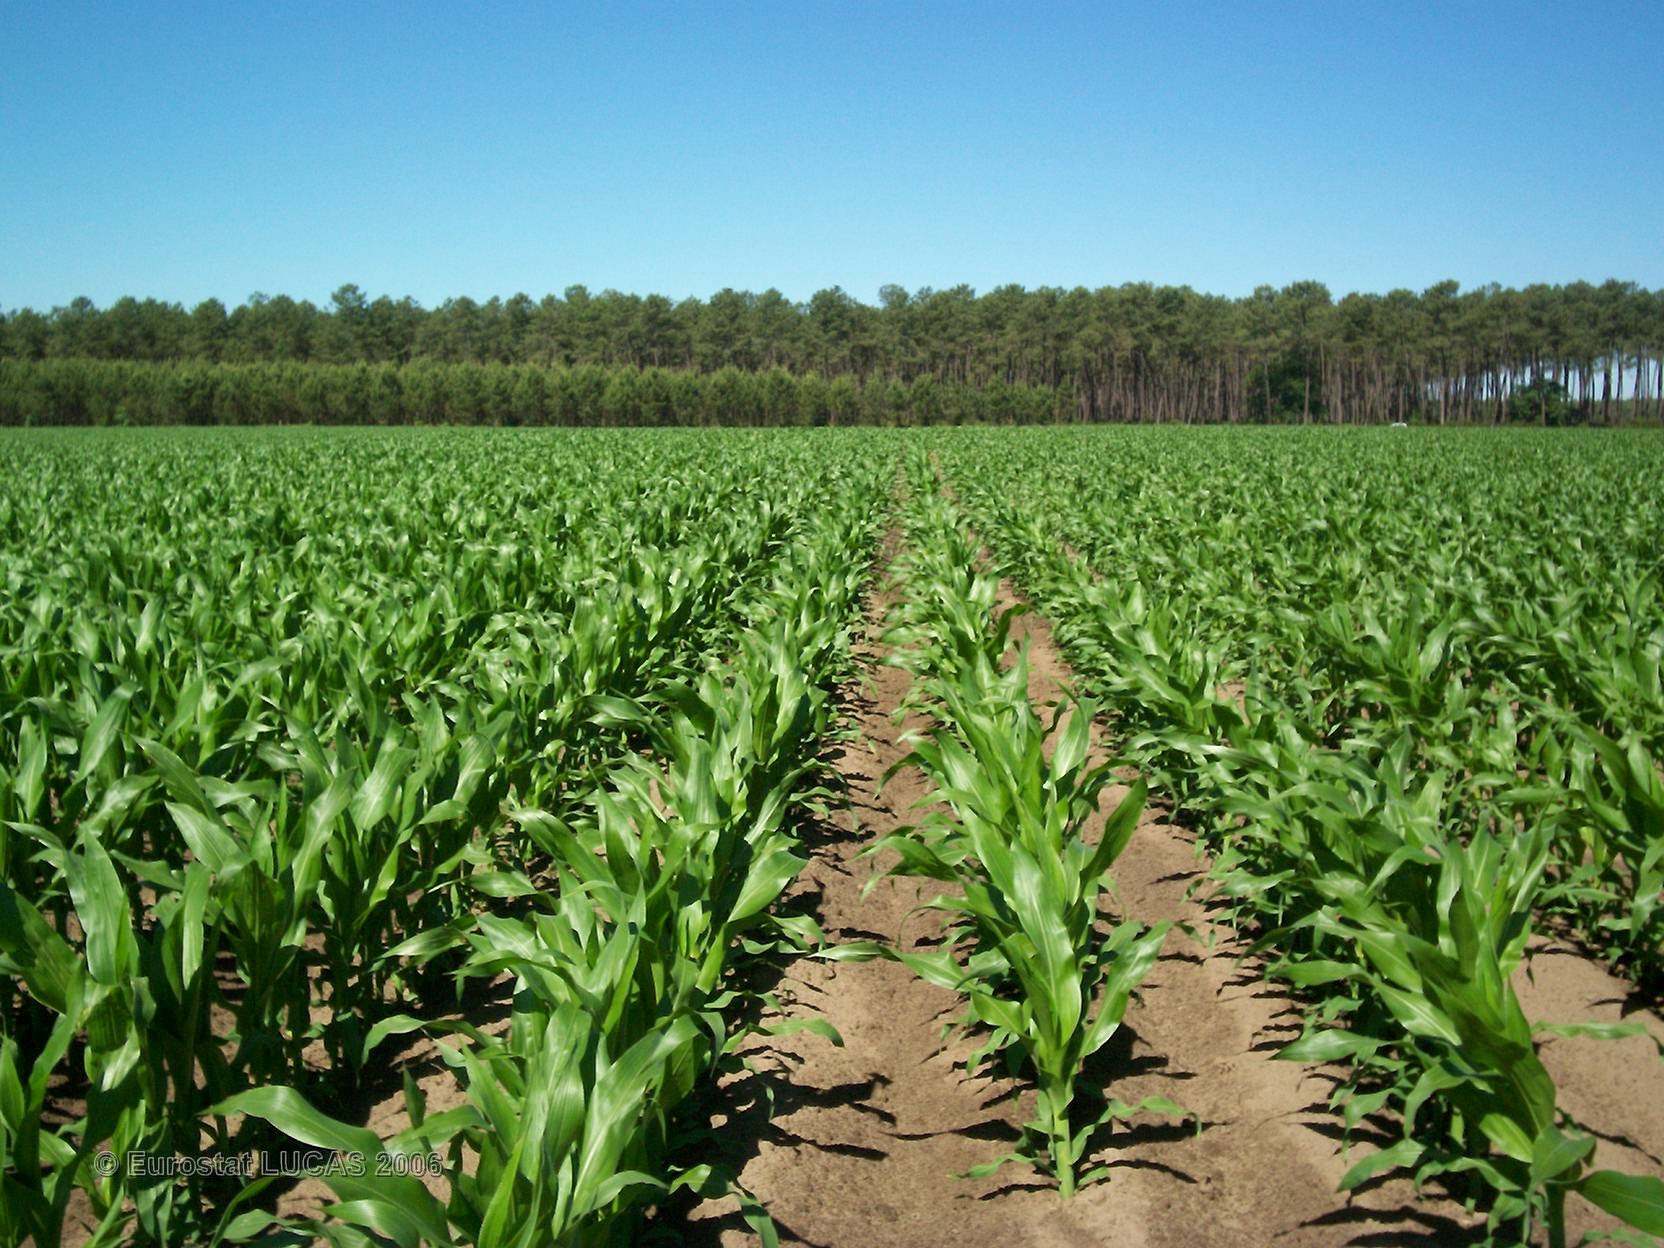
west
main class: Cropland
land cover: Maize
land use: Agriculture (excluding fallow land and kitchen gardens)
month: June
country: FR
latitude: 43.9803
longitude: -0.4970
